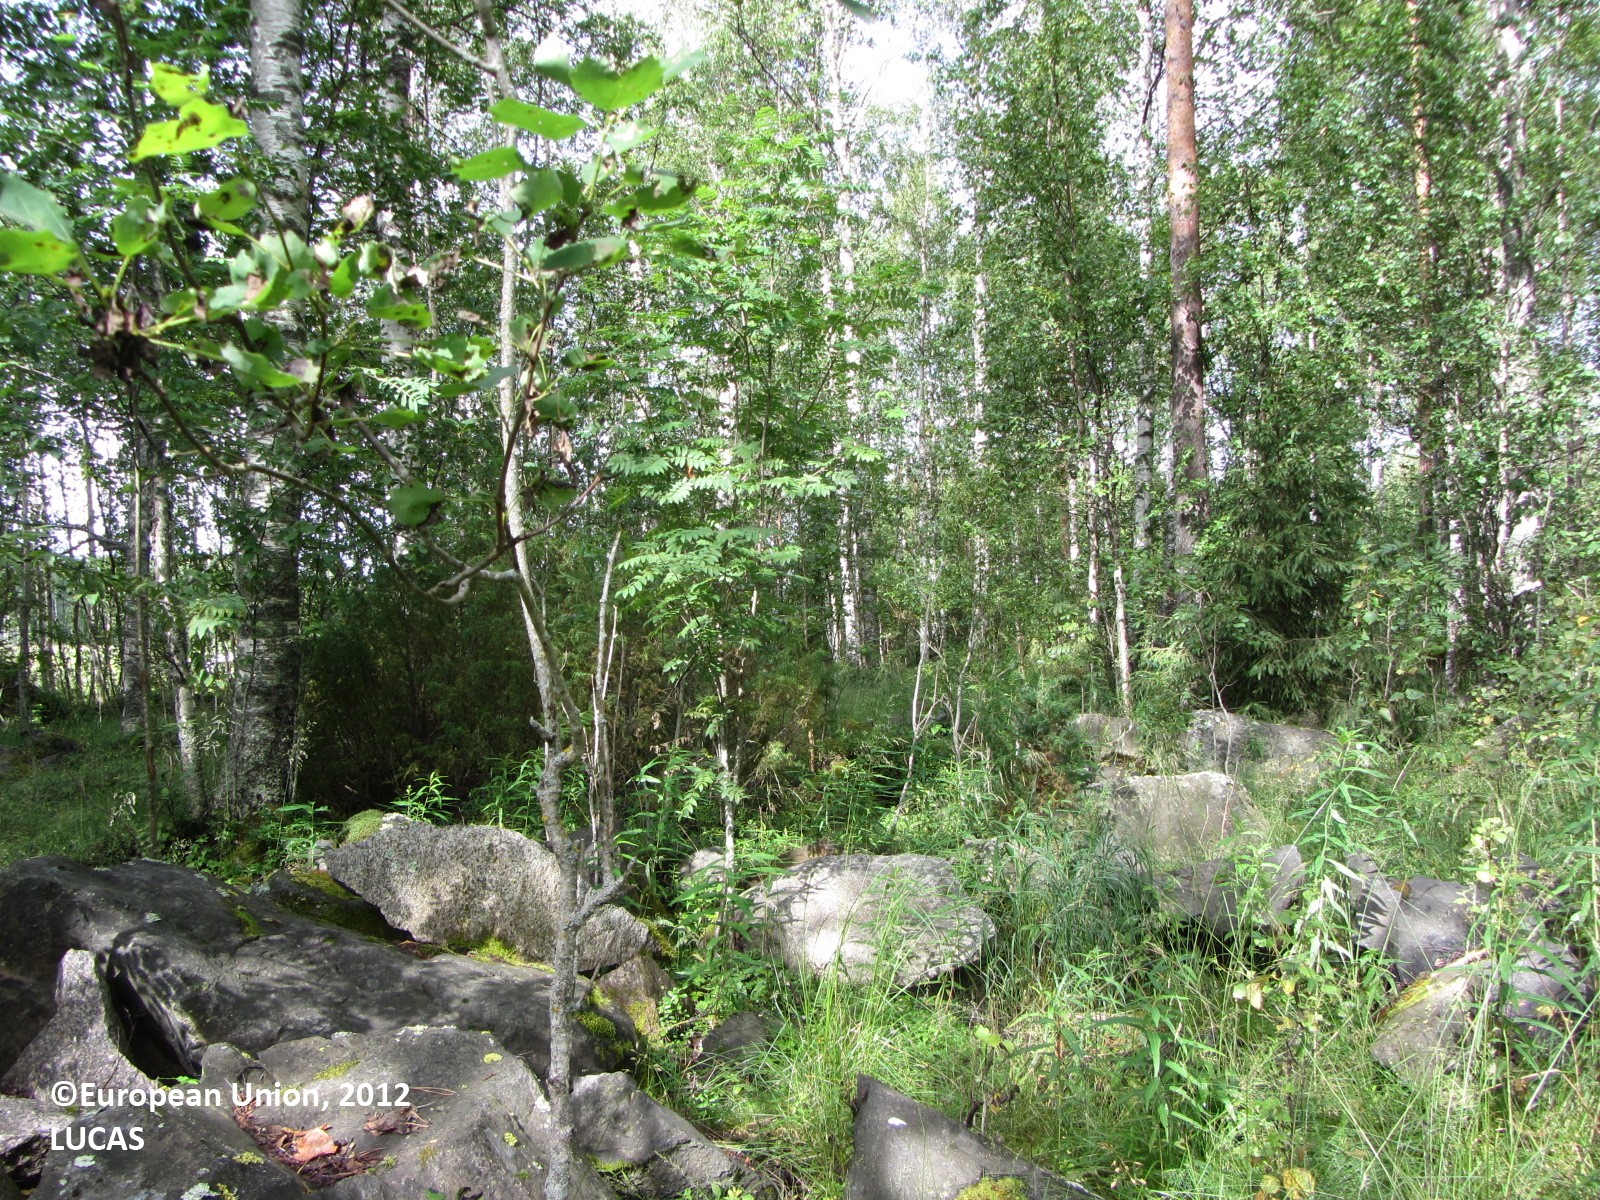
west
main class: Woodland
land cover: Broadleaved woodland
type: boreal forest
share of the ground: 50 - 75 %
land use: Forestry
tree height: > 5 m
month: July
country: FI
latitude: 63.8591
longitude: 24.6657
